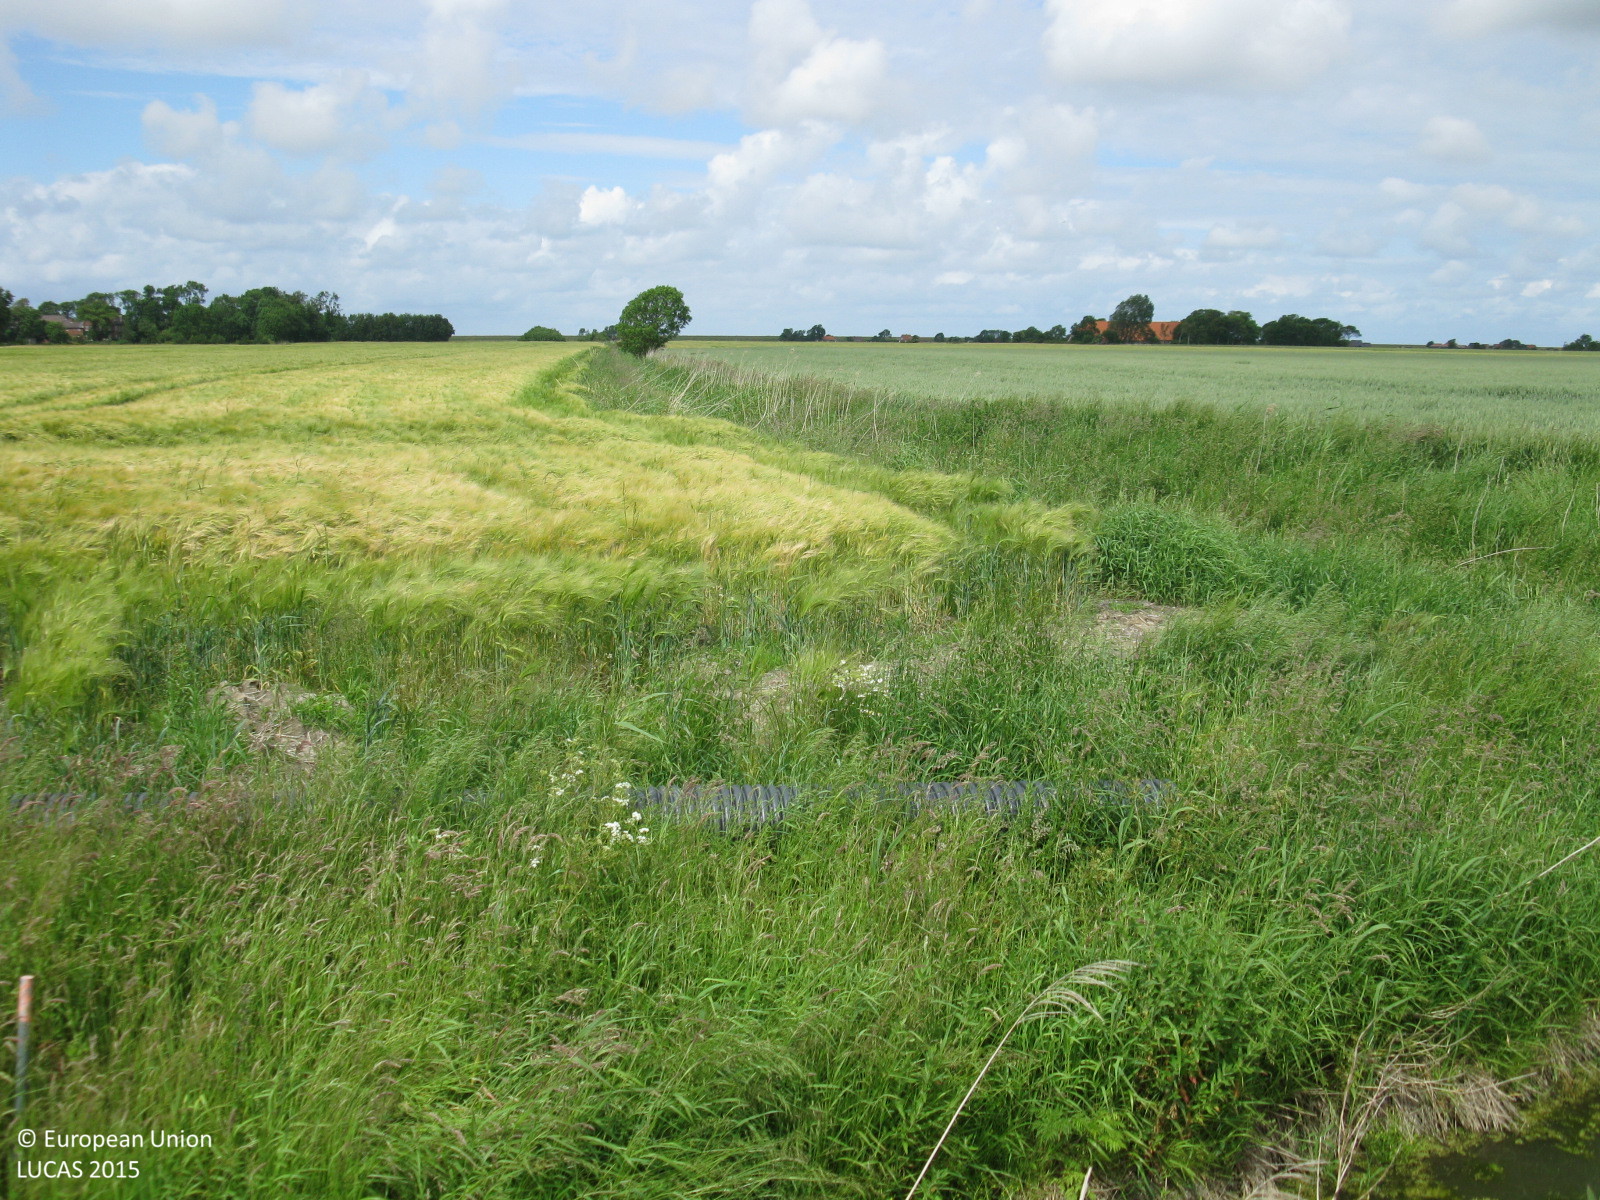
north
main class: Cropland
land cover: Barley
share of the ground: > 75 %
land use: Agriculture (excluding fallow land and kitchen gardens)
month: June
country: DE
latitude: 53.6601
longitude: 7.3223
